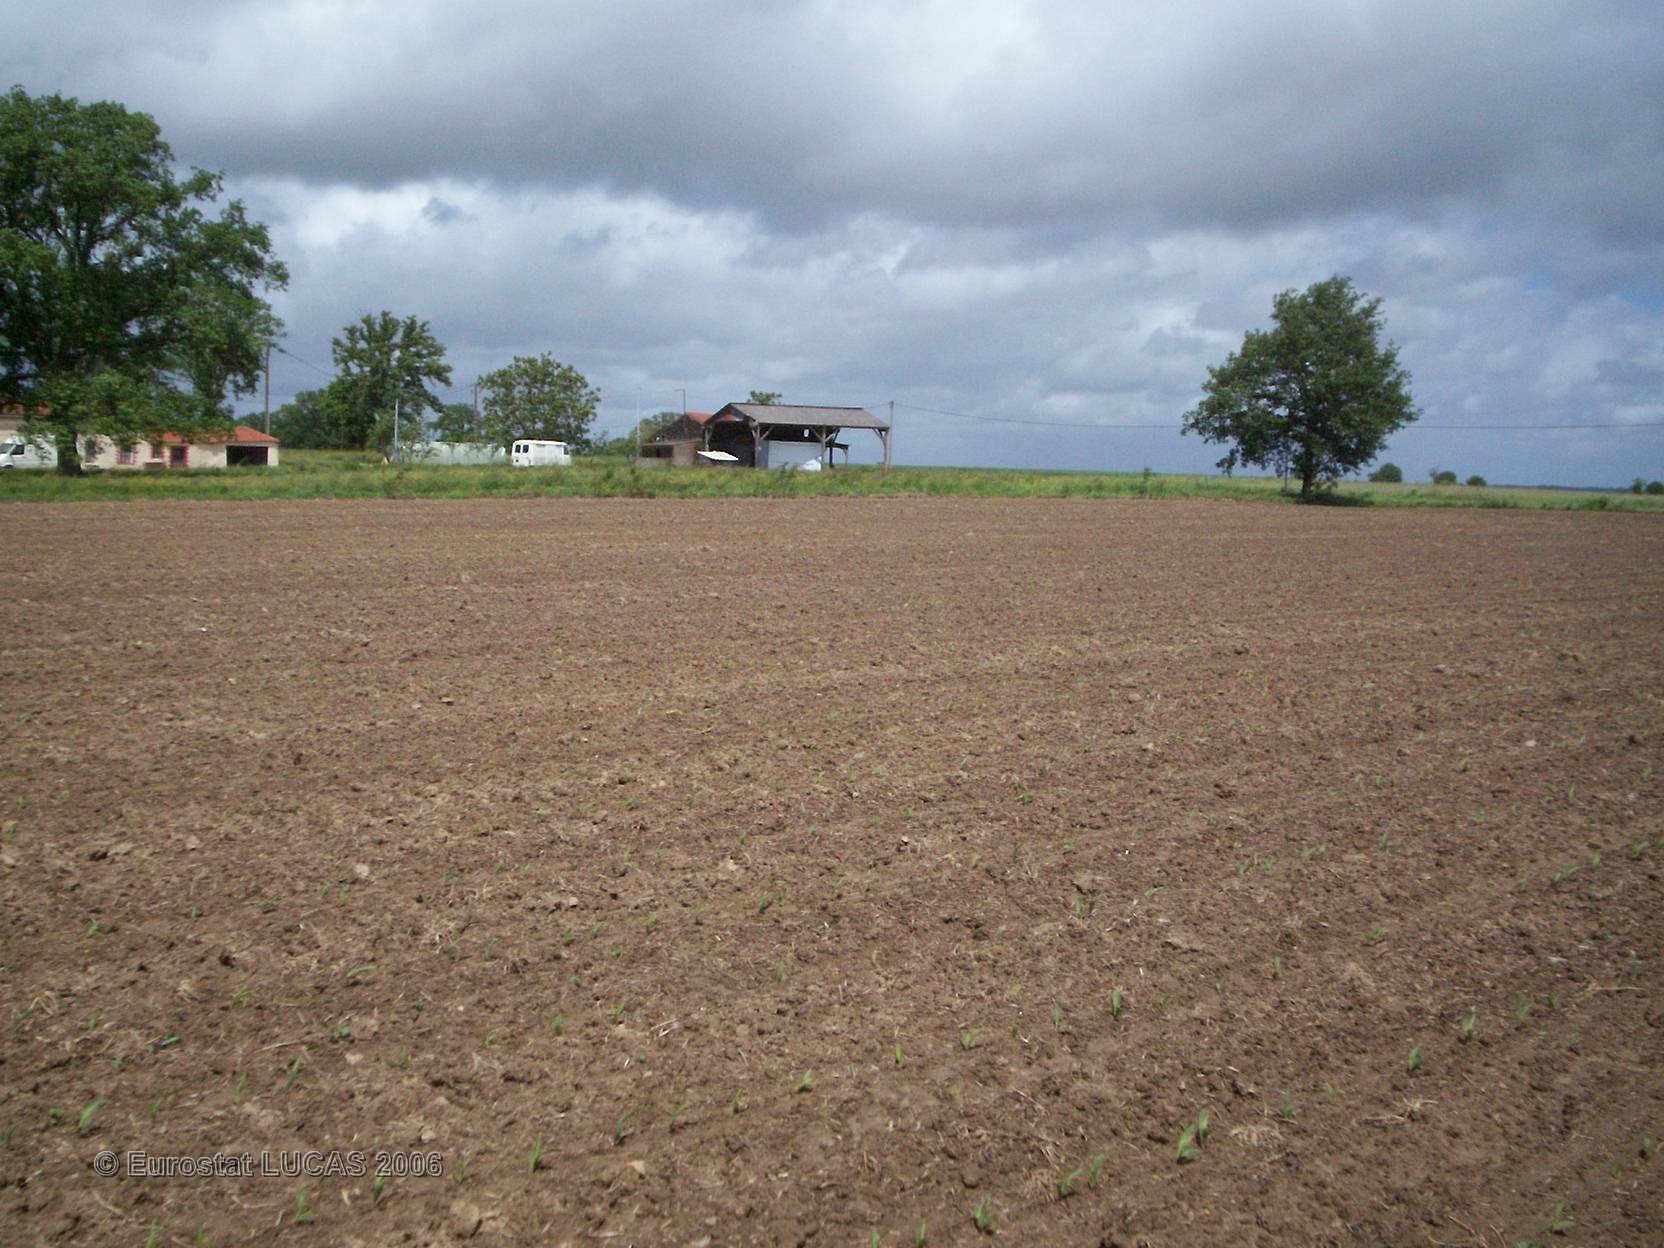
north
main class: Cropland
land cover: Maize
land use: Agriculture (excluding fallow land and kitchen gardens)
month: May
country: FR
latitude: 47.1755
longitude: -1.0530
